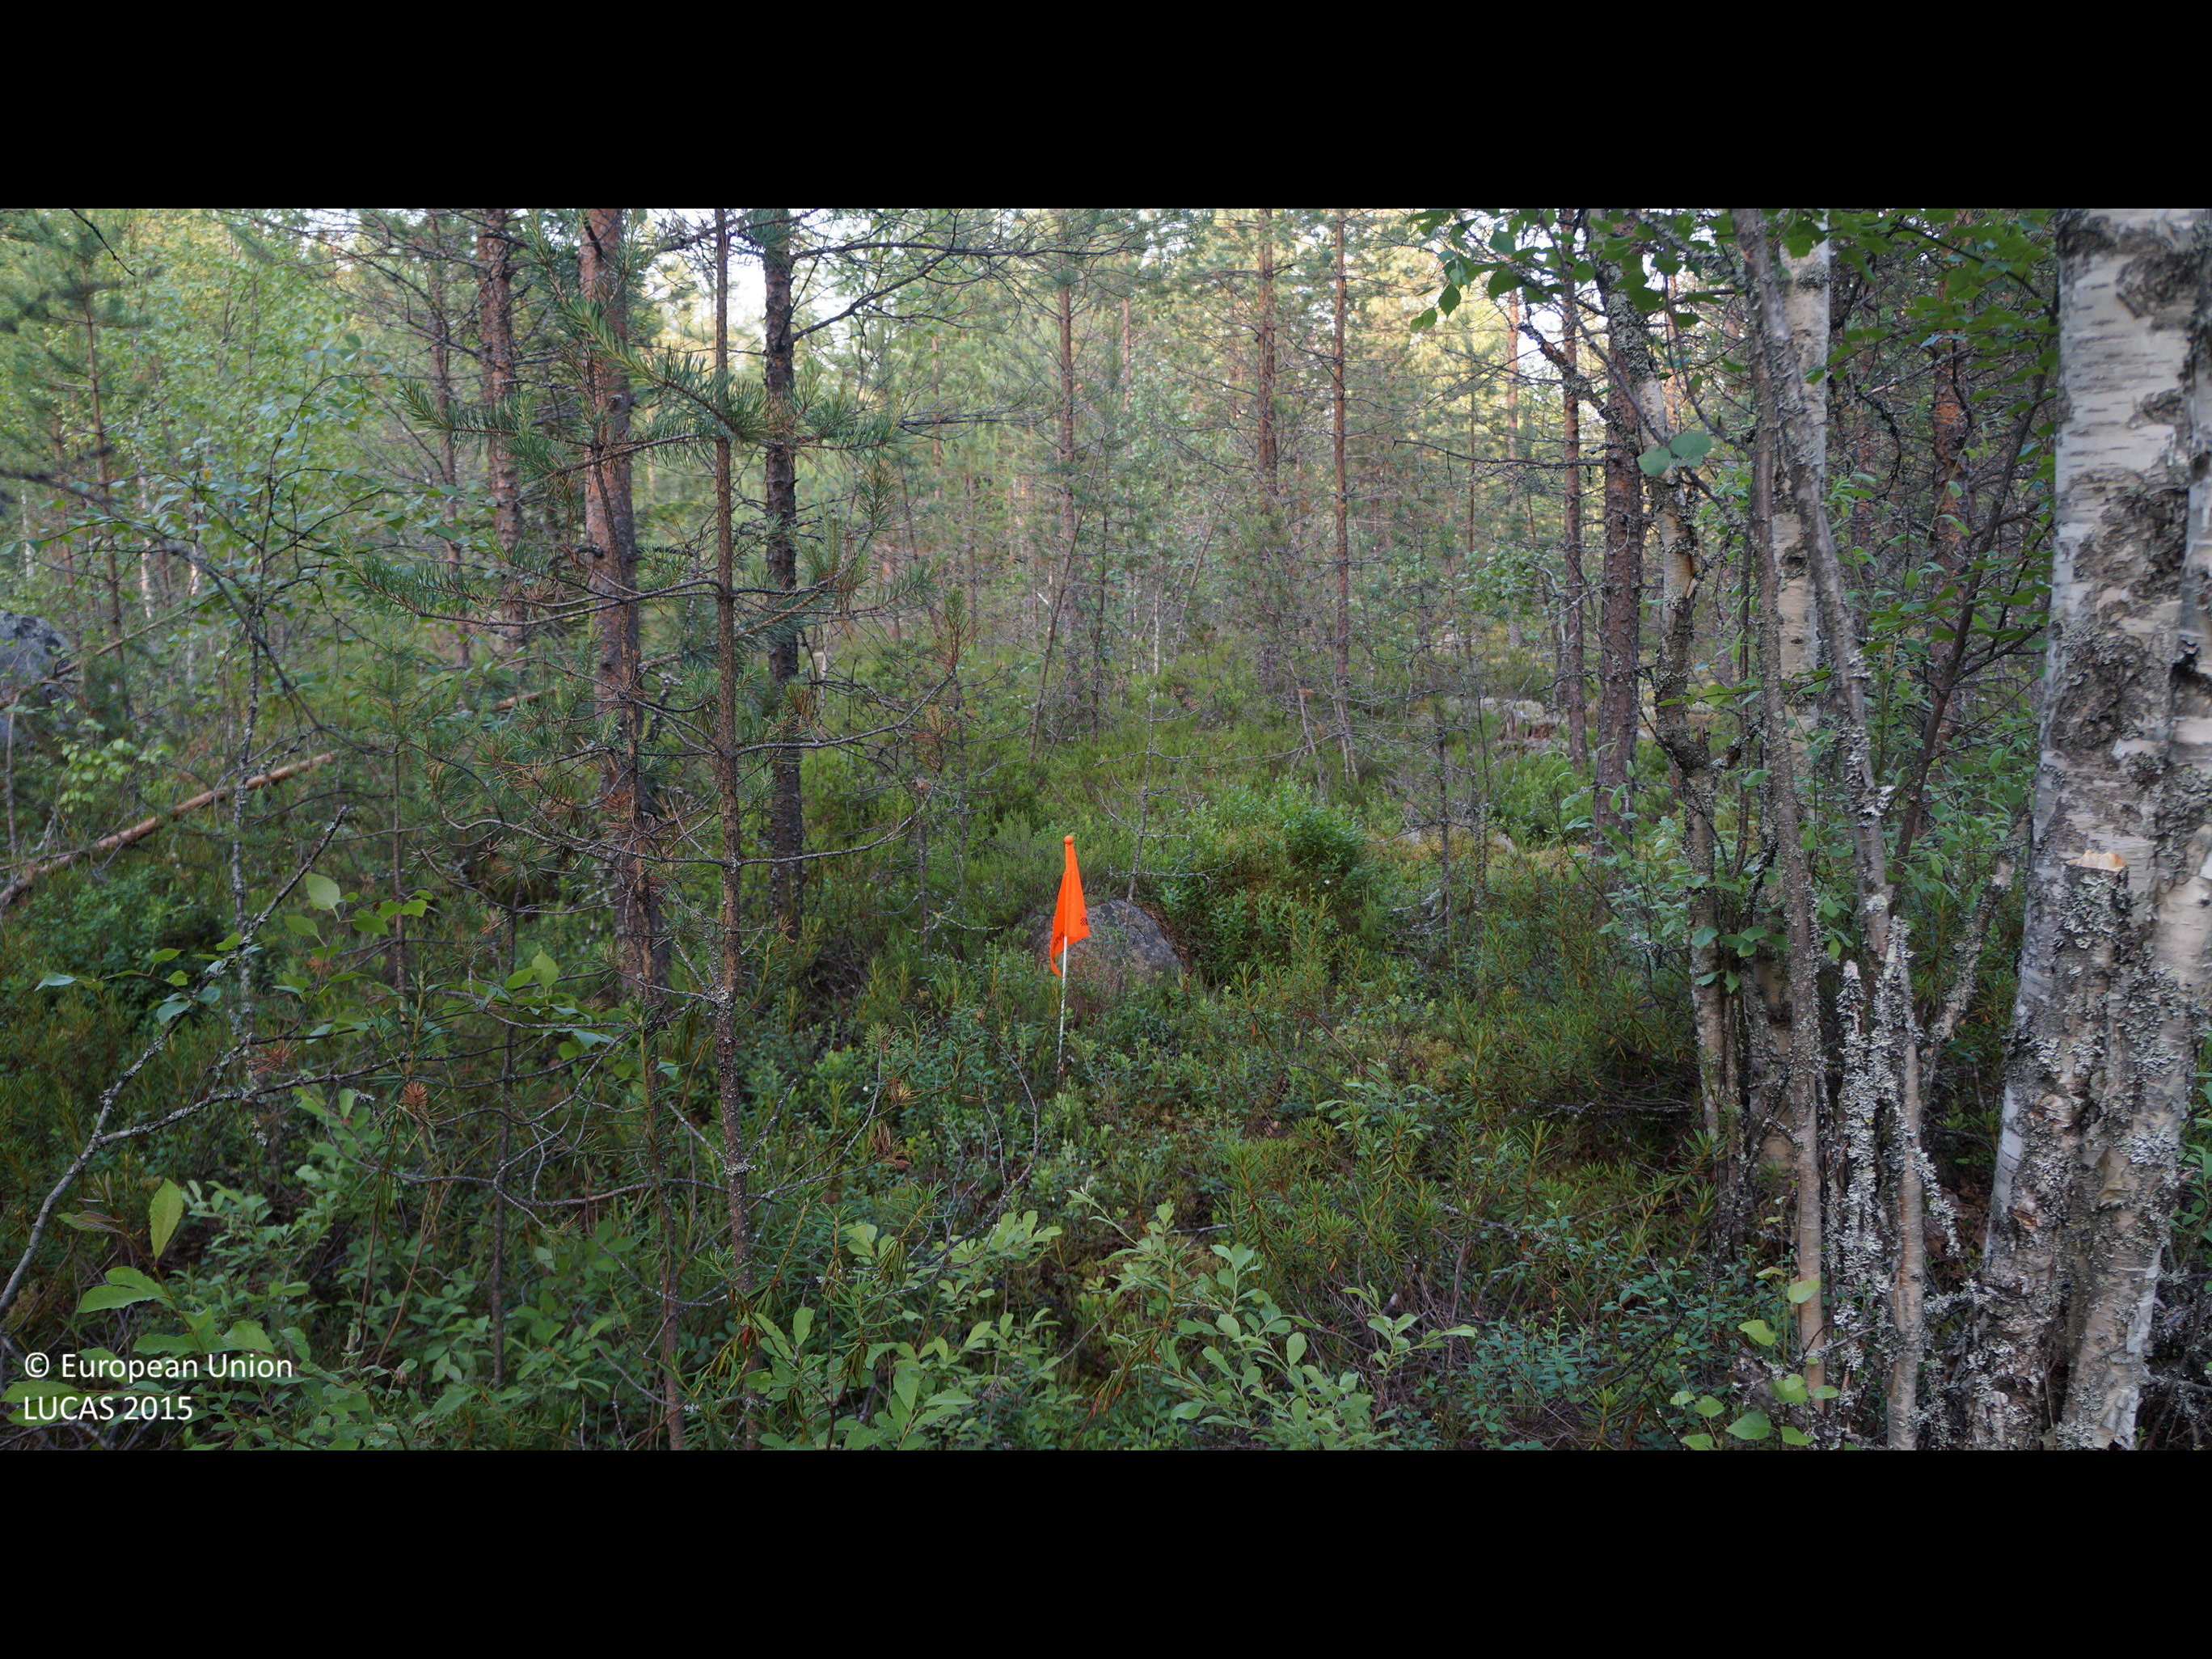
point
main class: Woodland
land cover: Pine dominated mixed woodland
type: boreal forest
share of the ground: 50 - 75 %
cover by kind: shrubs 40 %, coniferous forest trees 35 %, broadleaved forest trees 15 %, lichens and mosses 10 %
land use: Forestry
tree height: > 5 m
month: July
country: FI
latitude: 63.7734
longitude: 24.0014
